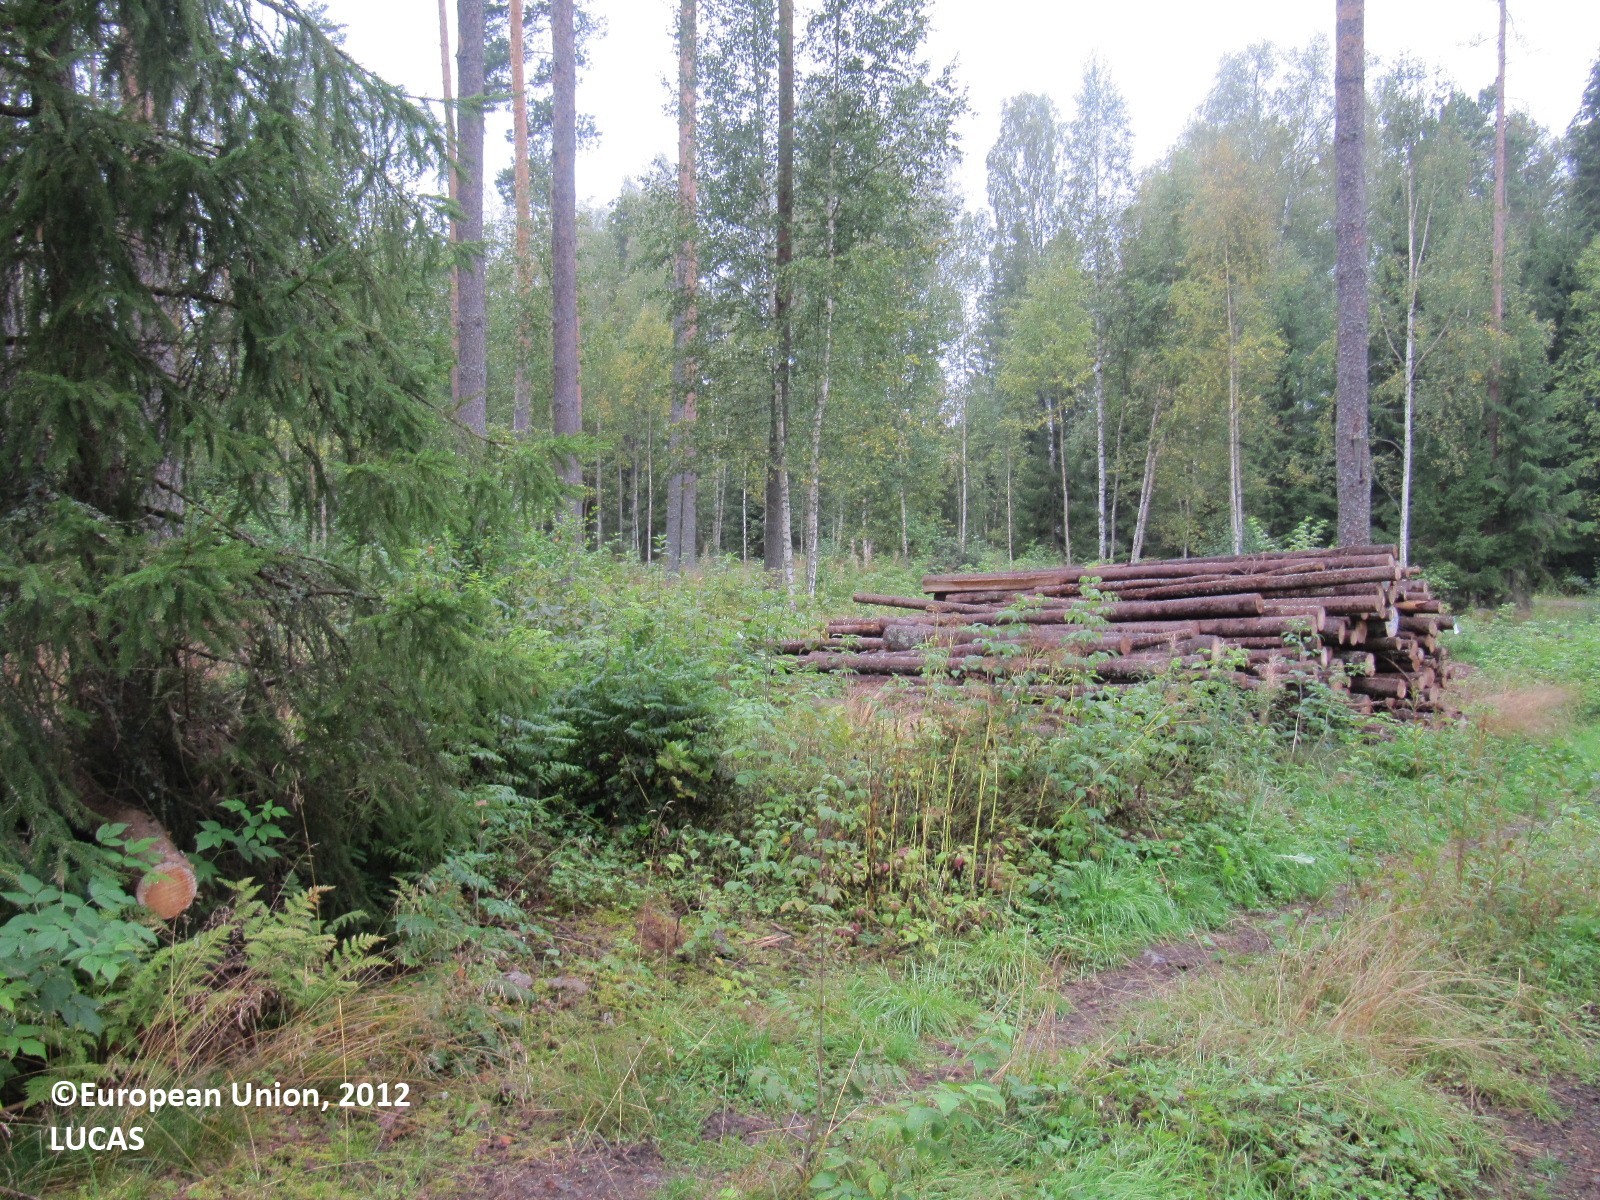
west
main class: Woodland
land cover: Pine dominated mixed woodland
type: boreal forest
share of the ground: 25 - 50 %
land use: Forestry
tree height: > 5 m
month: August
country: FI
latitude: 61.0393
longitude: 23.3923
